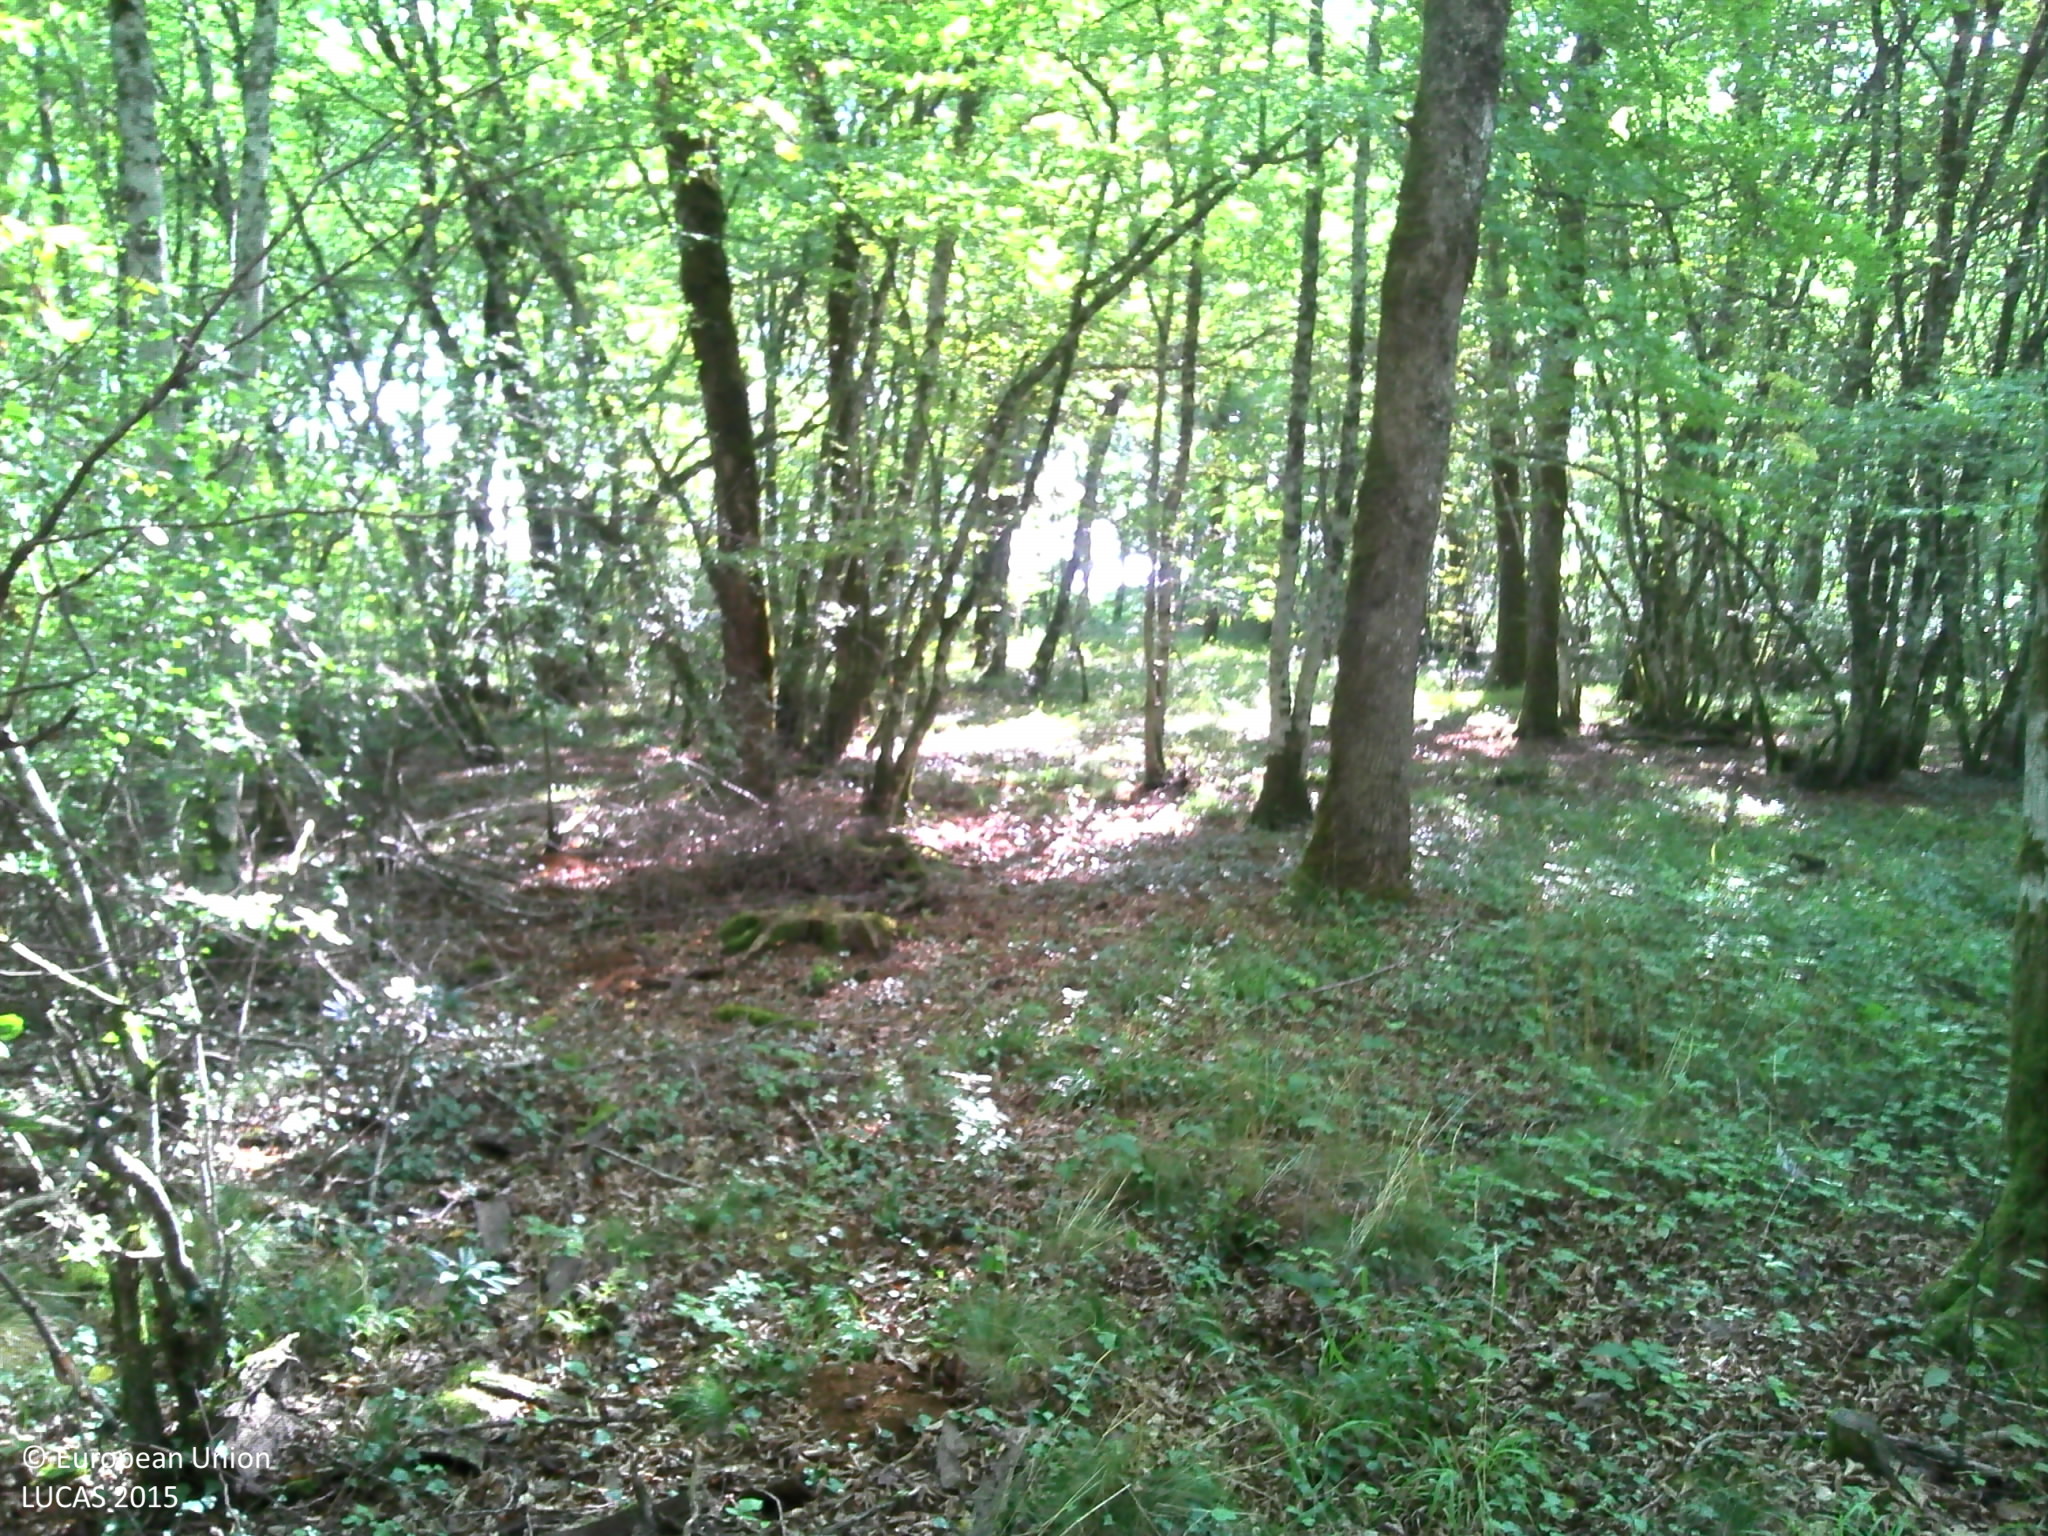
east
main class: Woodland
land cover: Broadleaved woodland
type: mesophytic deciduous forest
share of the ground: > 75 %
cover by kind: broadleaved forest trees 80 %, shrubs 10 %, herbaceous plants 10 %
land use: Forestry
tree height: > 5 m
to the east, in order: Broadleaved woodland; Grass margins; Rape and turnip rape
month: August
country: FR
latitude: 47.2010
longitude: 4.8389
